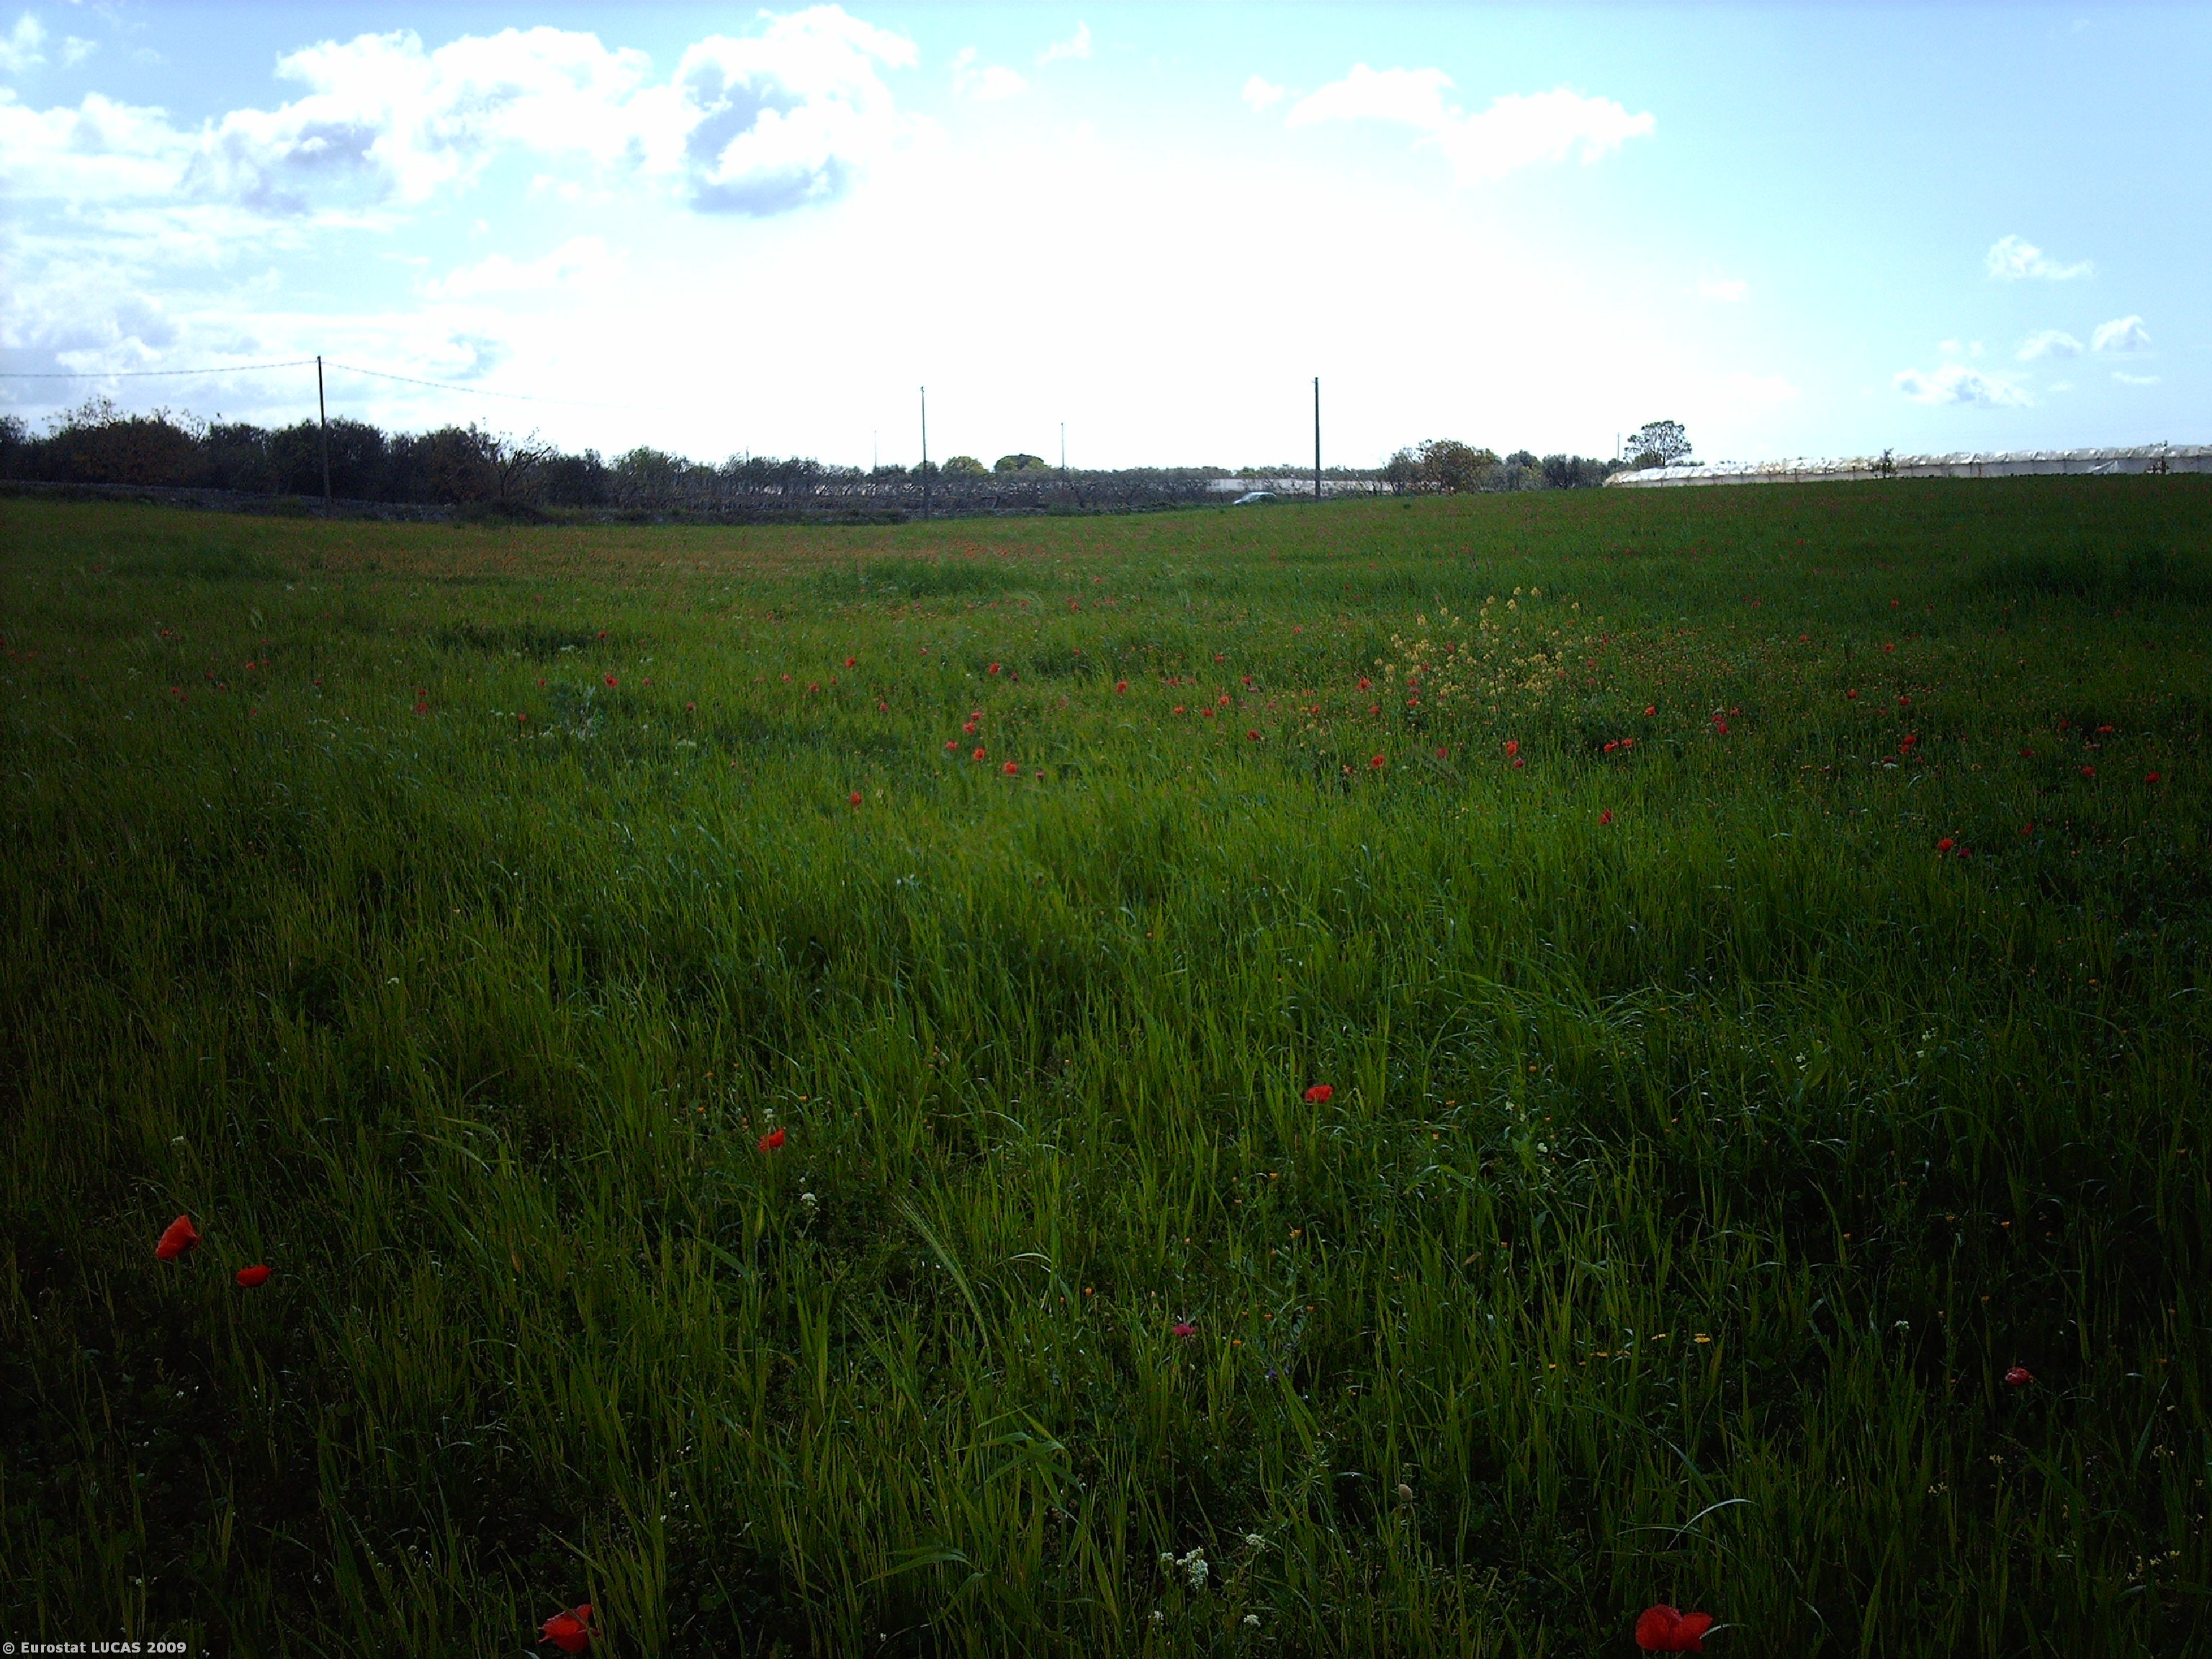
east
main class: Cropland
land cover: Mixed cereals for fodder
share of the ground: > 75 %
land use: Agriculture (excluding fallow land and kitchen gardens)
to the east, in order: Mixed cereals for fodder; Electric lines; Grass margins; Dry stone walls; Grass margins; Paved roads, cycling and walking lanes; Dry stone walls; Olive groves; Vineyards; Olive groves; Nuts trees
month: April
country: IT
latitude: 40.8252
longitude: 16.8667
